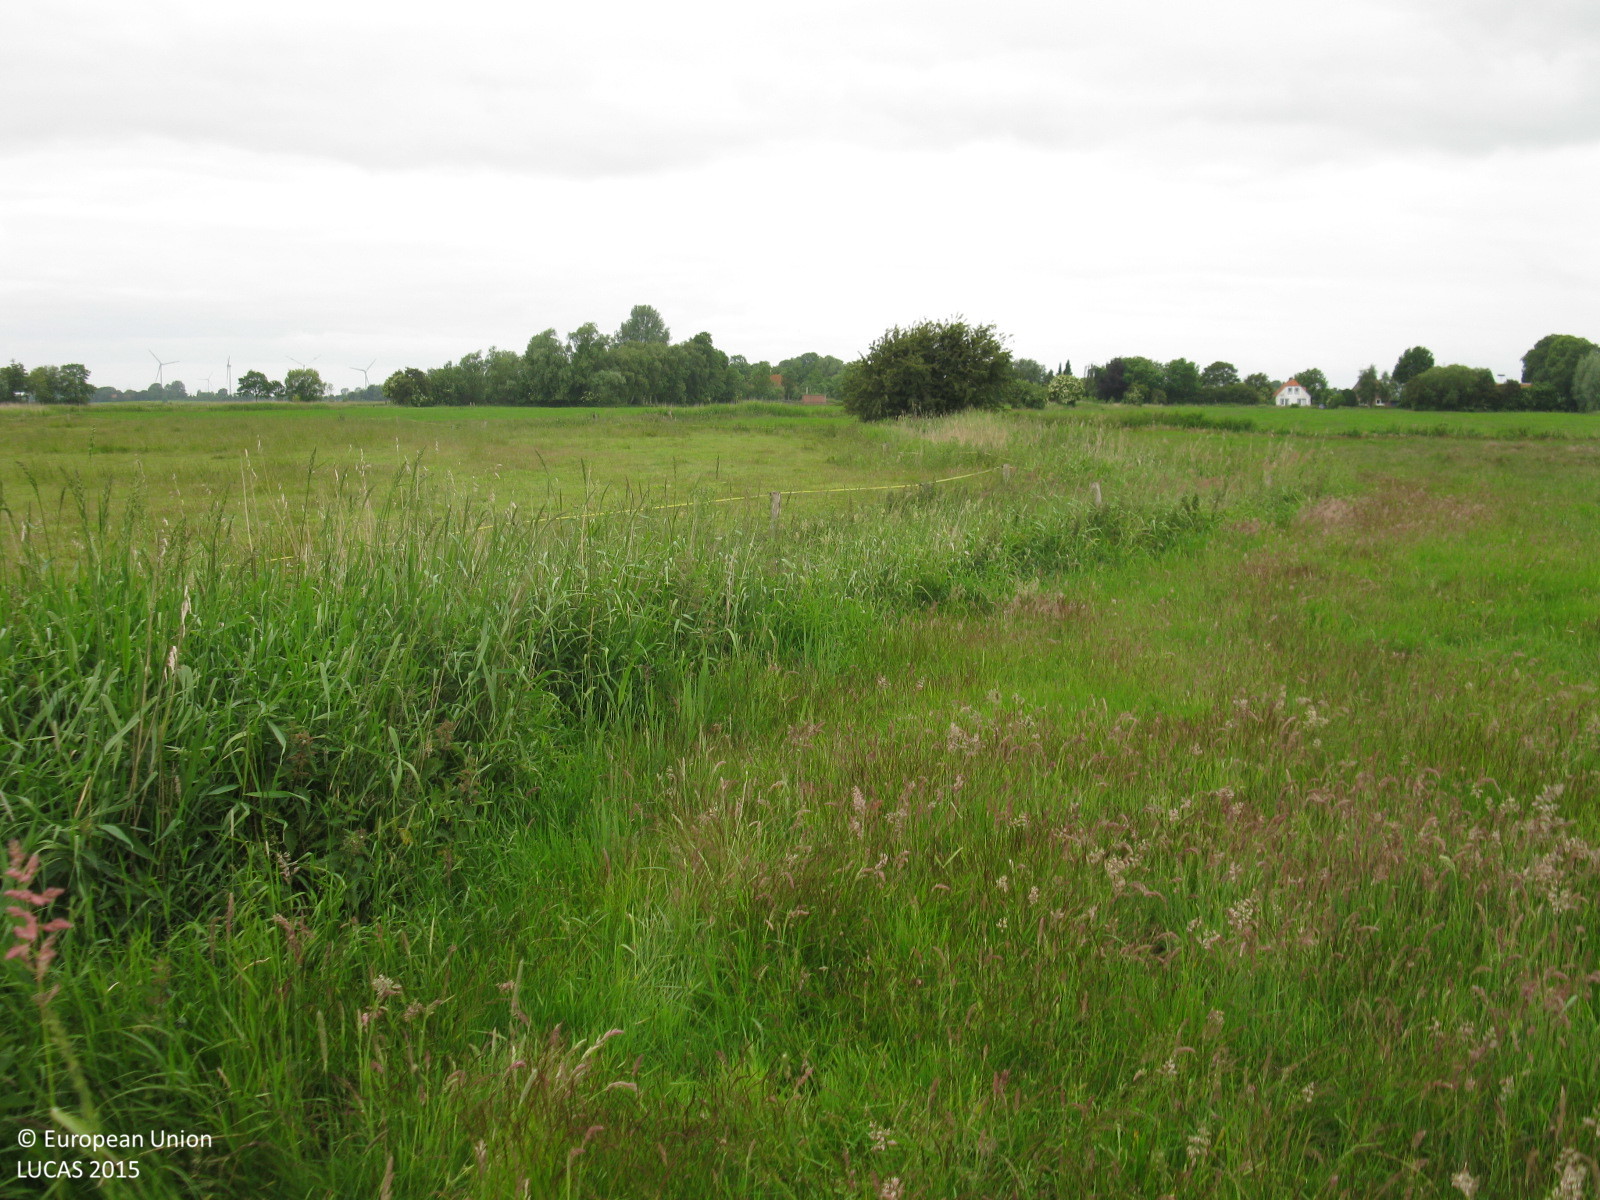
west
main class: Grassland
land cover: Grassland without tree/shrub cover
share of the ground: > 75 %
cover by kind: herbaceous plants 100 %
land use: Agriculture (excluding fallow land and kitchen gardens)
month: June
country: DE
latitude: 53.6005
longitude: 7.9607
